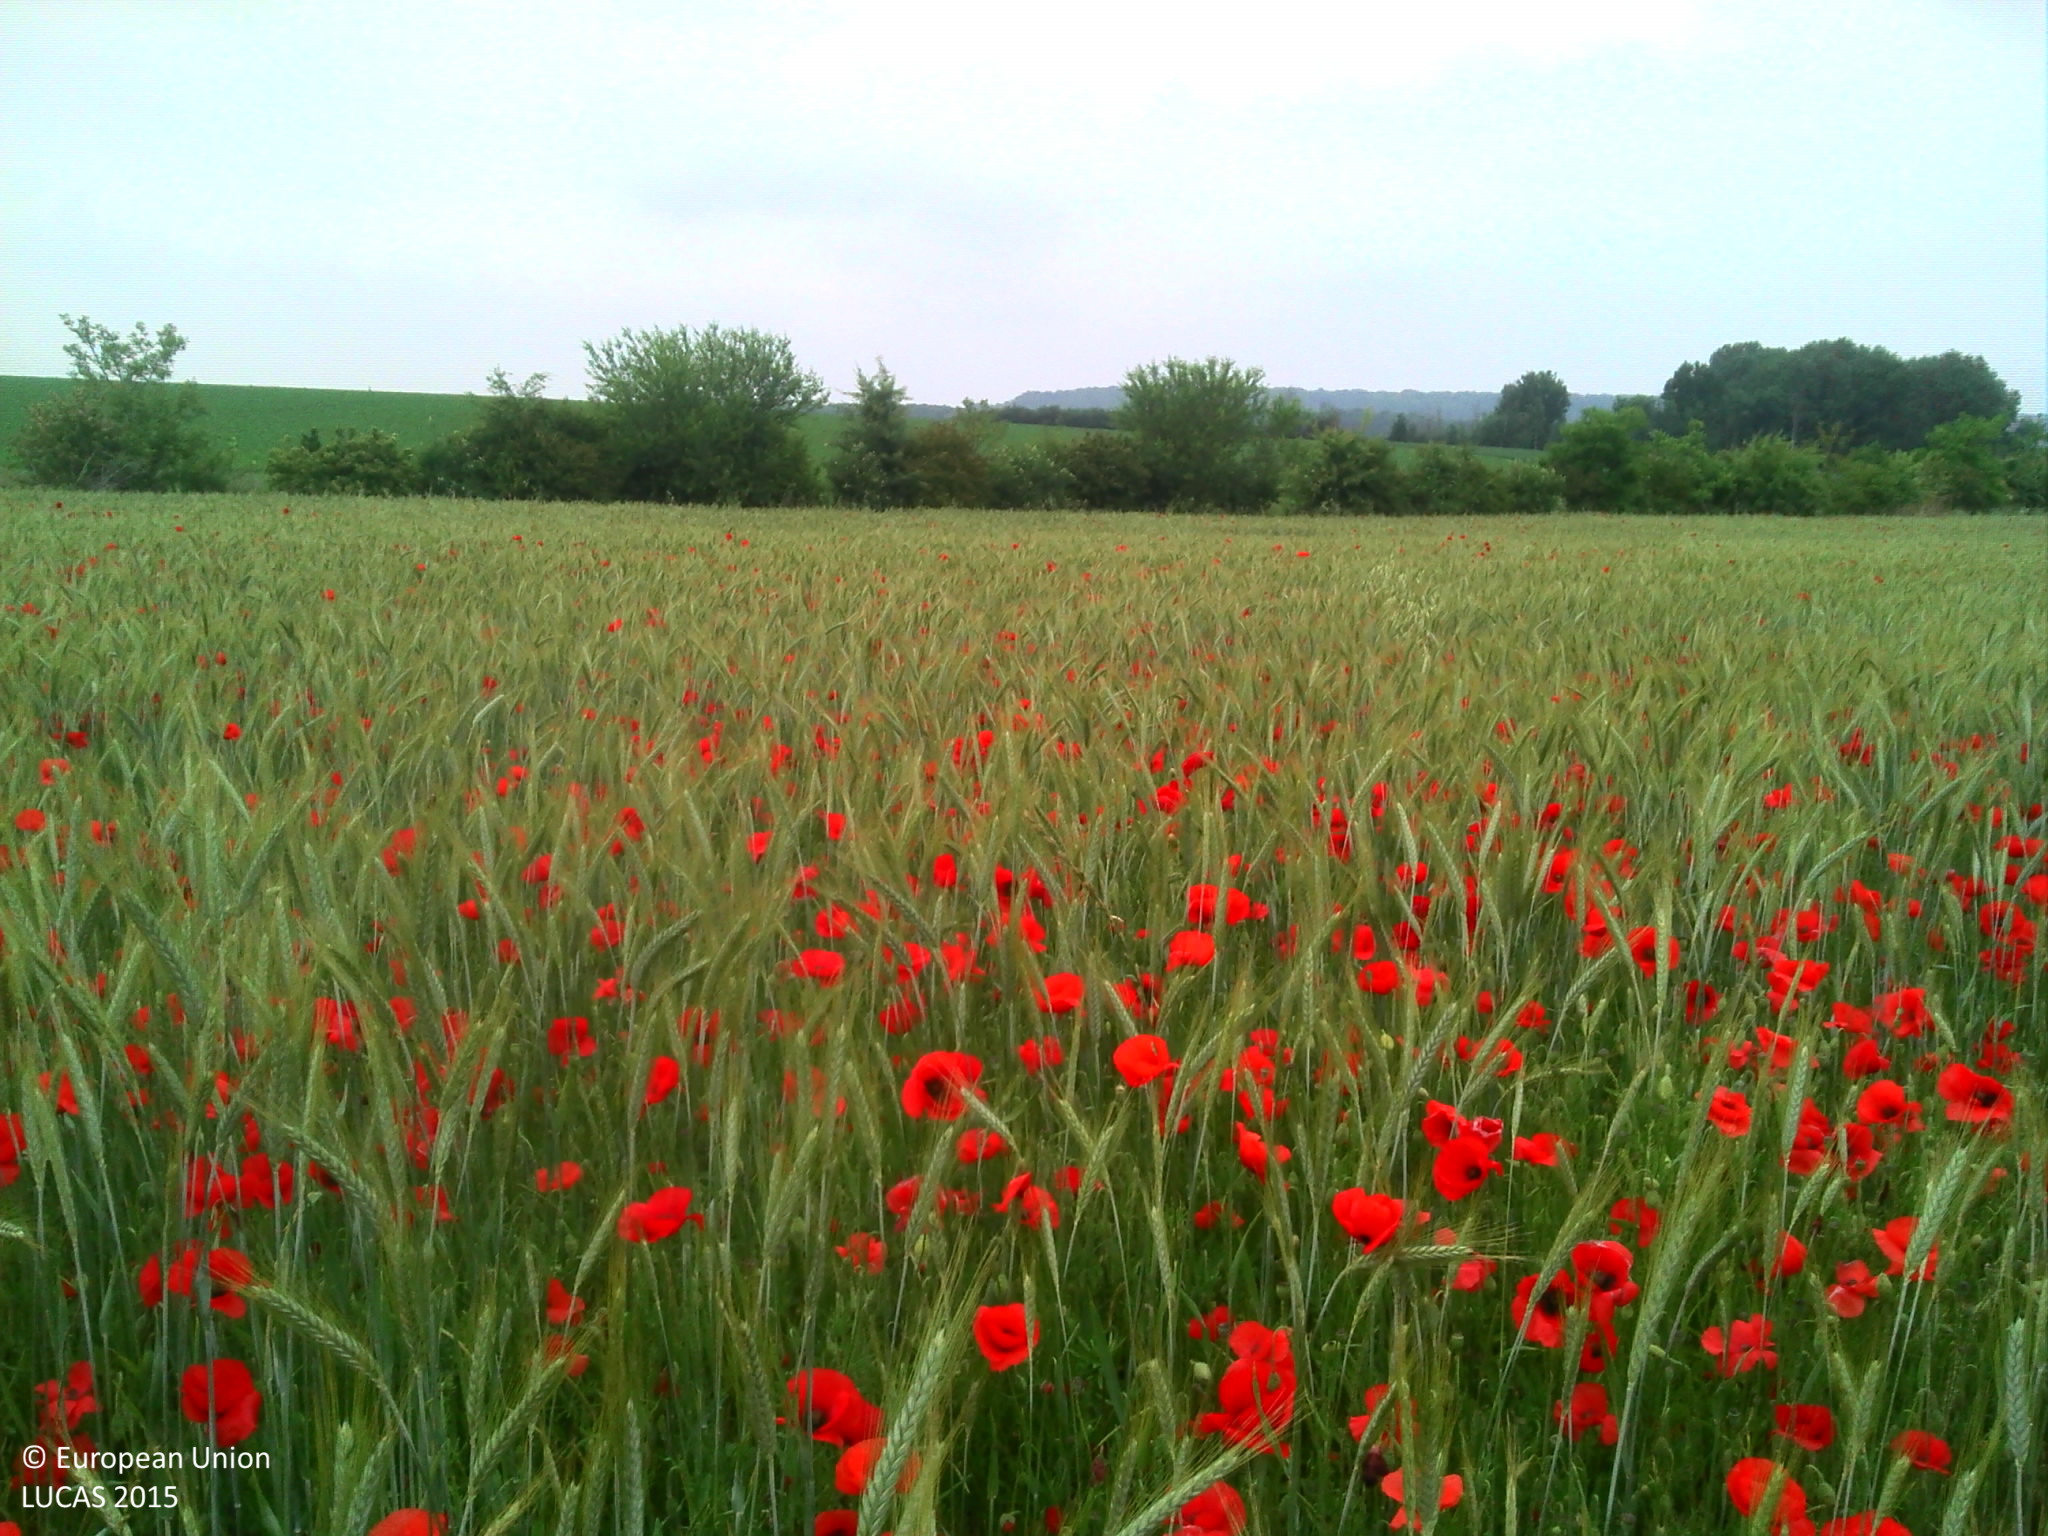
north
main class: Cropland
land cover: Barley
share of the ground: > 75 %
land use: Agriculture (excluding fallow land and kitchen gardens)
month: June
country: FR
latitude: 49.7363
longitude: 2.2021
